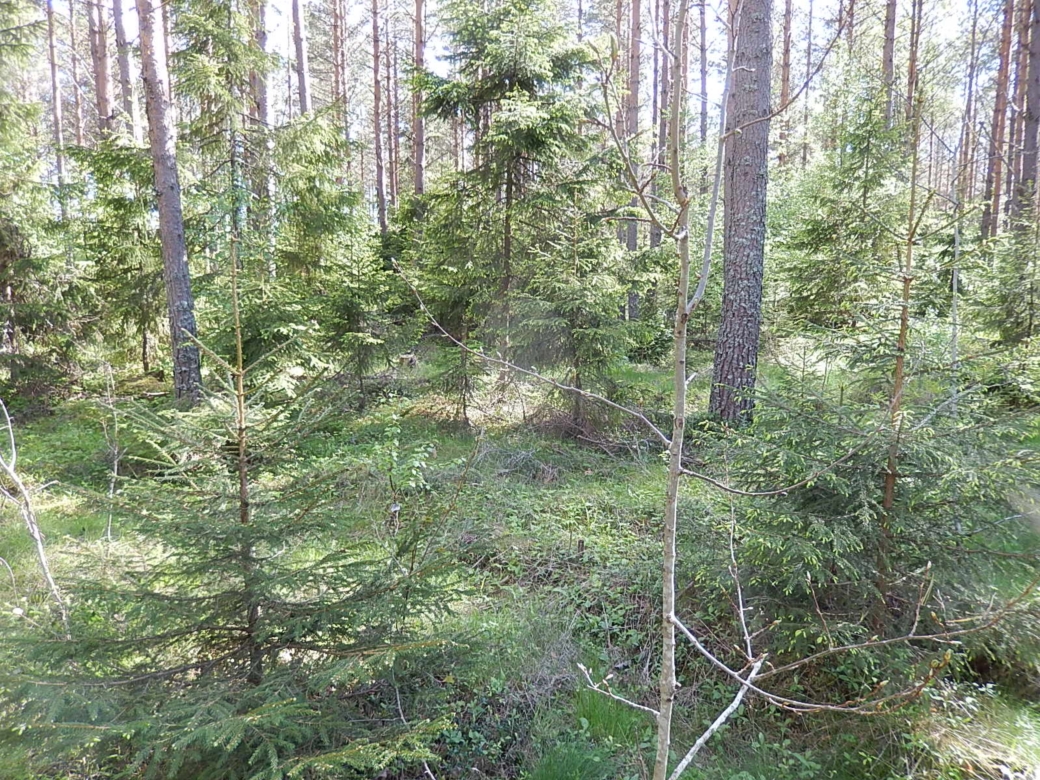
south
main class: Woodland
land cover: Pine dominated coniferous woodland
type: boreal forest
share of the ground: > 75 %
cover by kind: coniferous forest trees 75 %, herbaceous plants 15 %, broadleaved forest trees 10 %
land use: Forestry
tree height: > 5 m
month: June
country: FI
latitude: 61.9745
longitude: 21.4359
